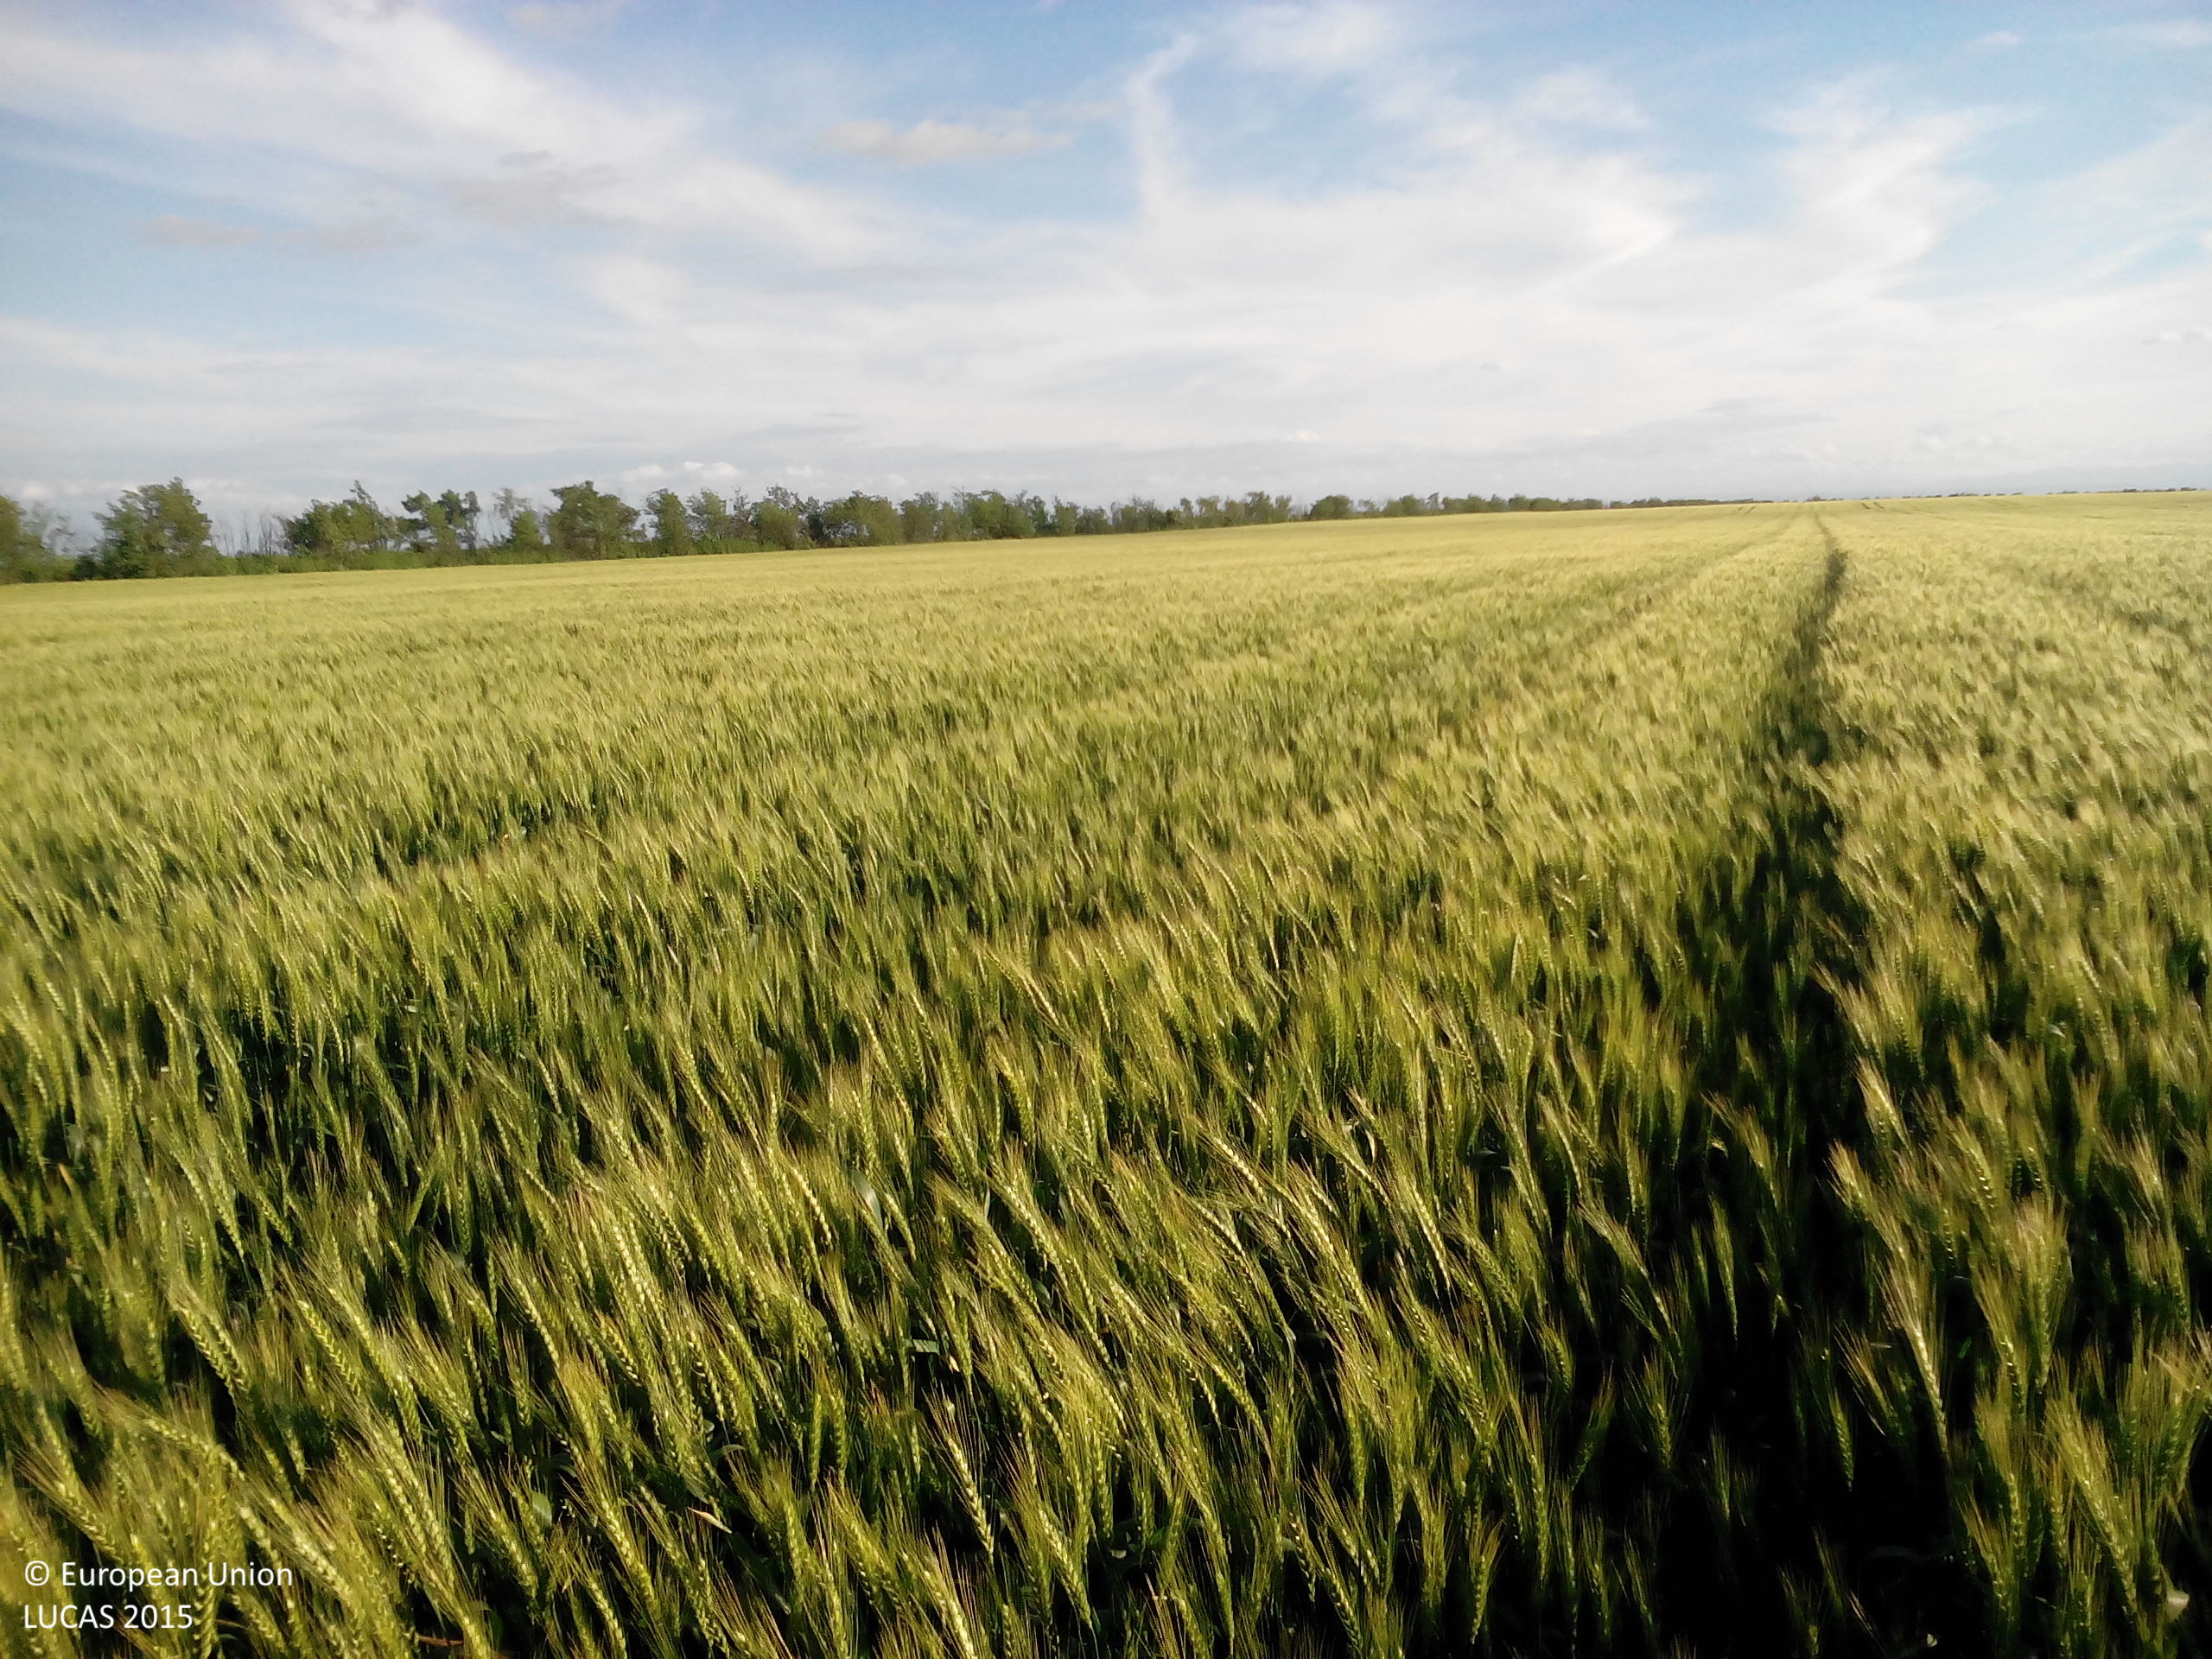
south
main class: Cropland
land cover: Common wheat
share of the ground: > 75 %
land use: Agriculture (excluding fallow land and kitchen gardens)
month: May
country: BG
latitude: 43.5994
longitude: 24.1159
